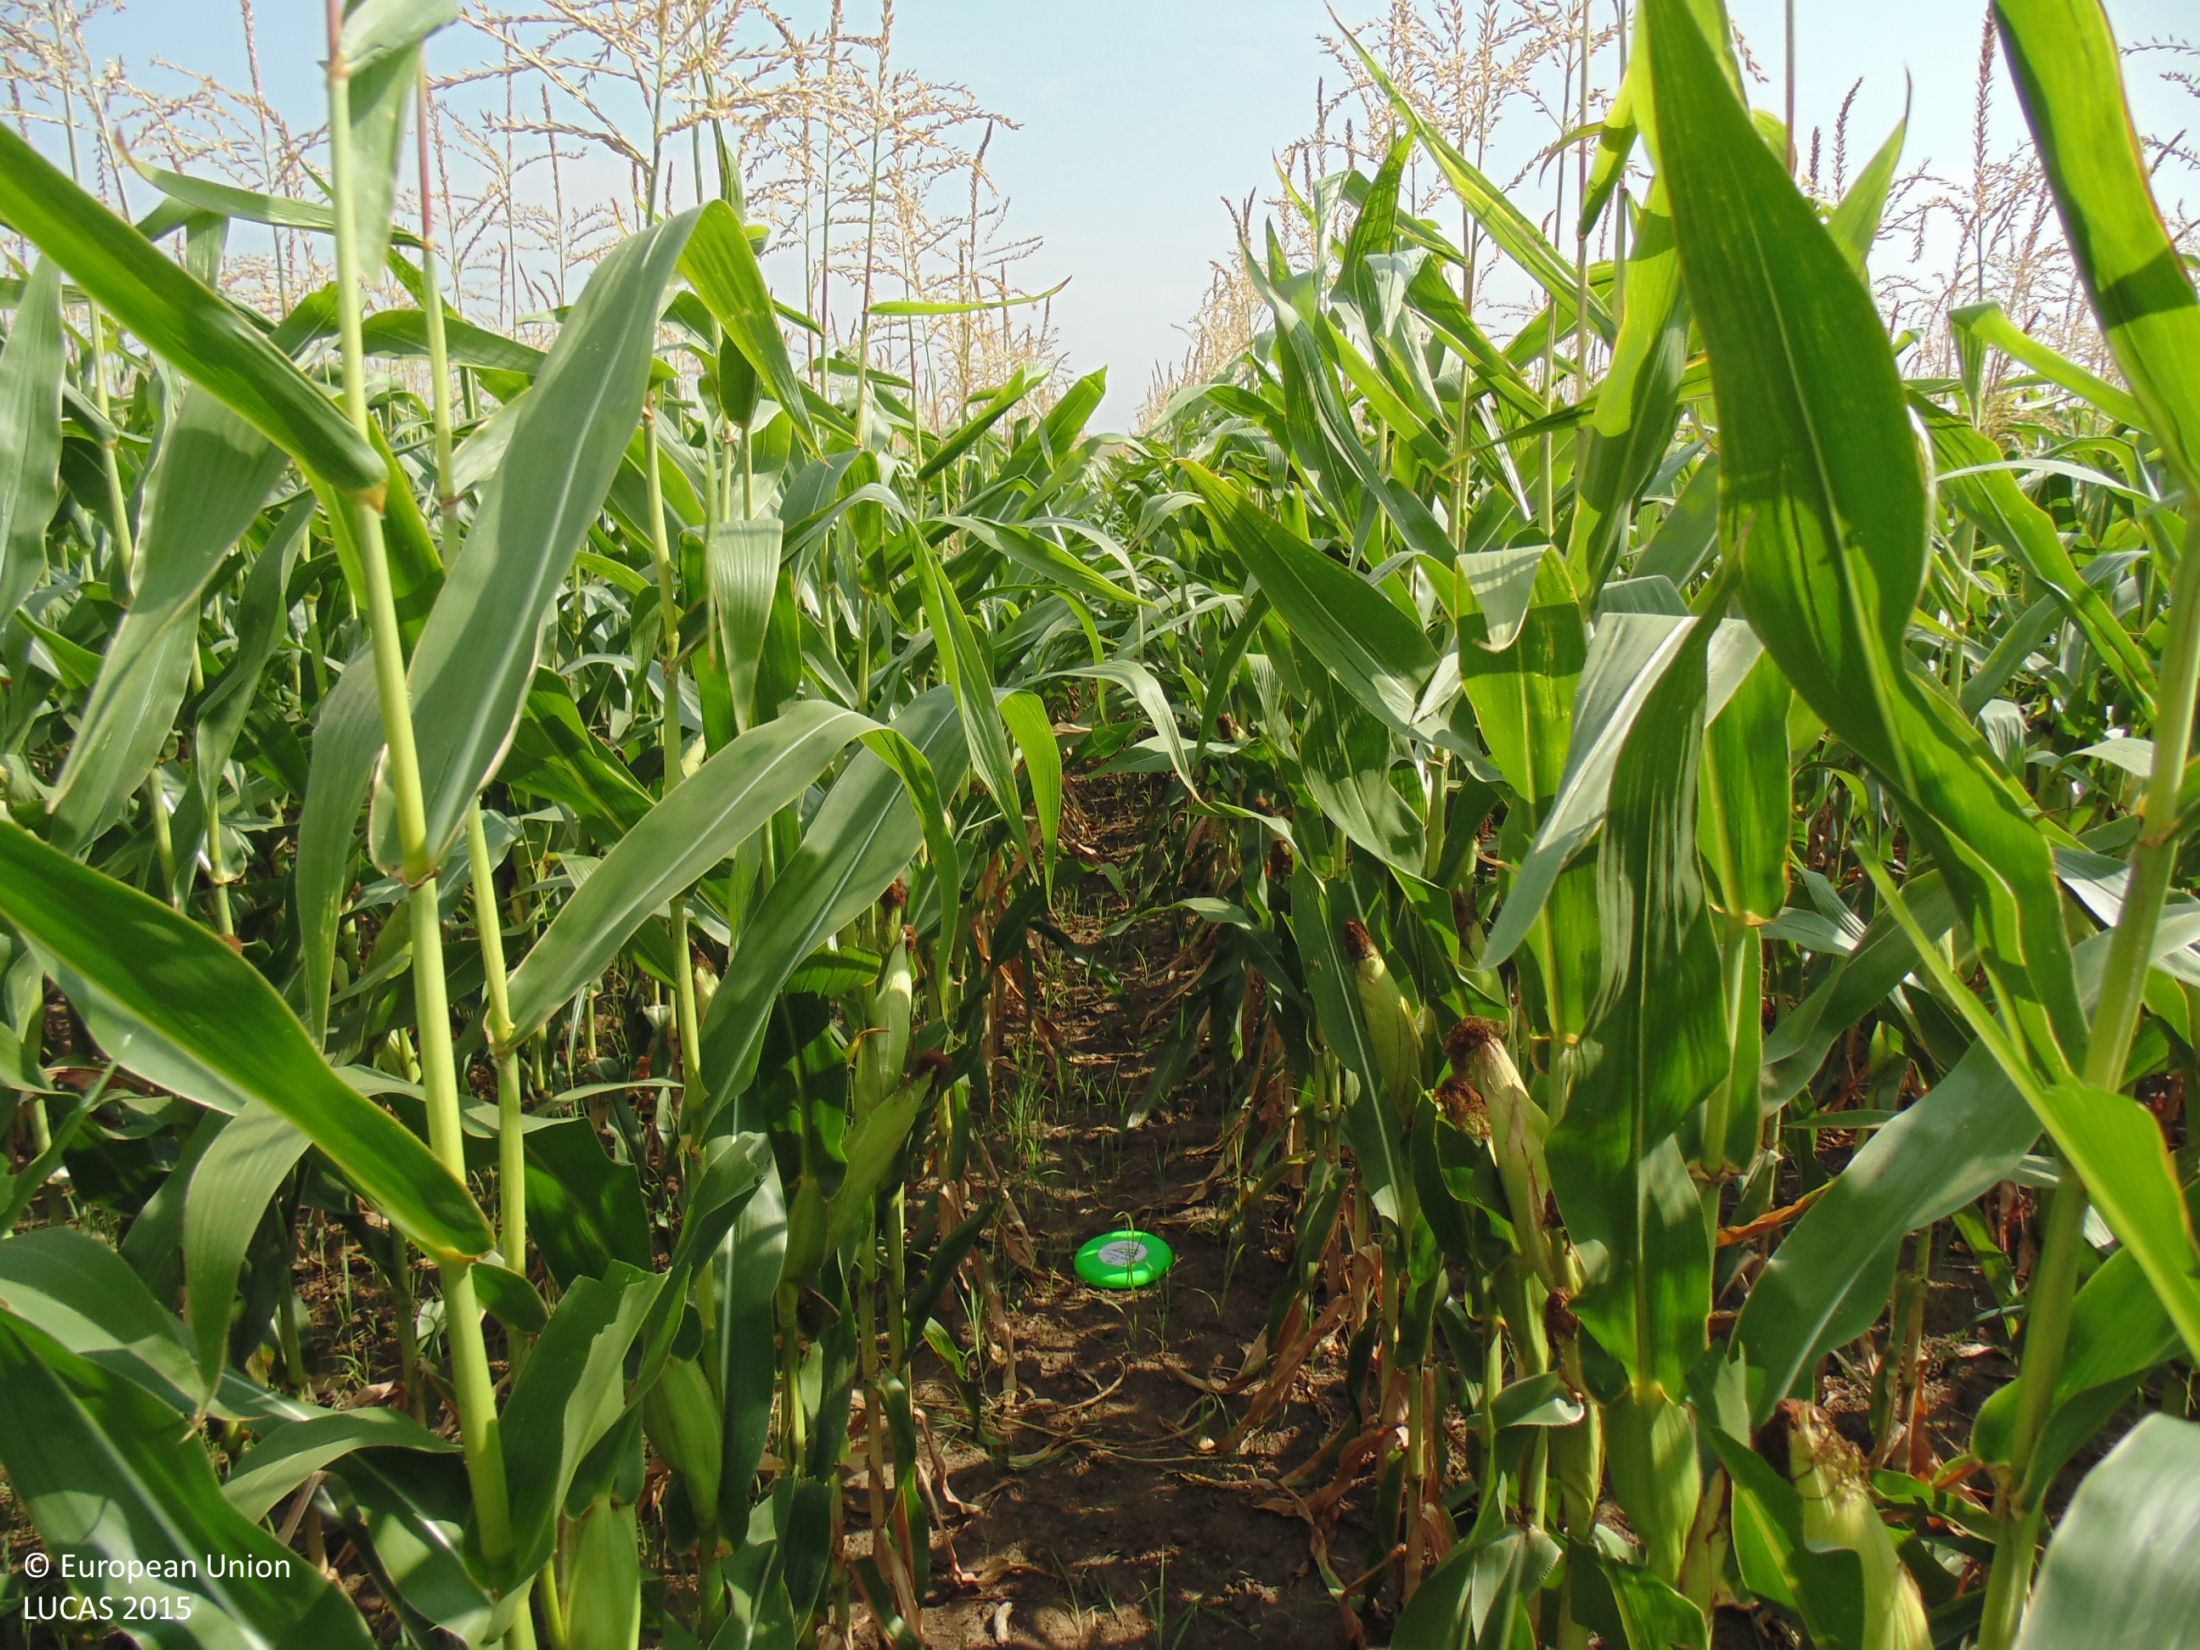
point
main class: Cropland
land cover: Maize
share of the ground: > 75 %
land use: Agriculture (excluding fallow land and kitchen gardens)
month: August
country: BG
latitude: 43.8226
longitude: 28.0434
